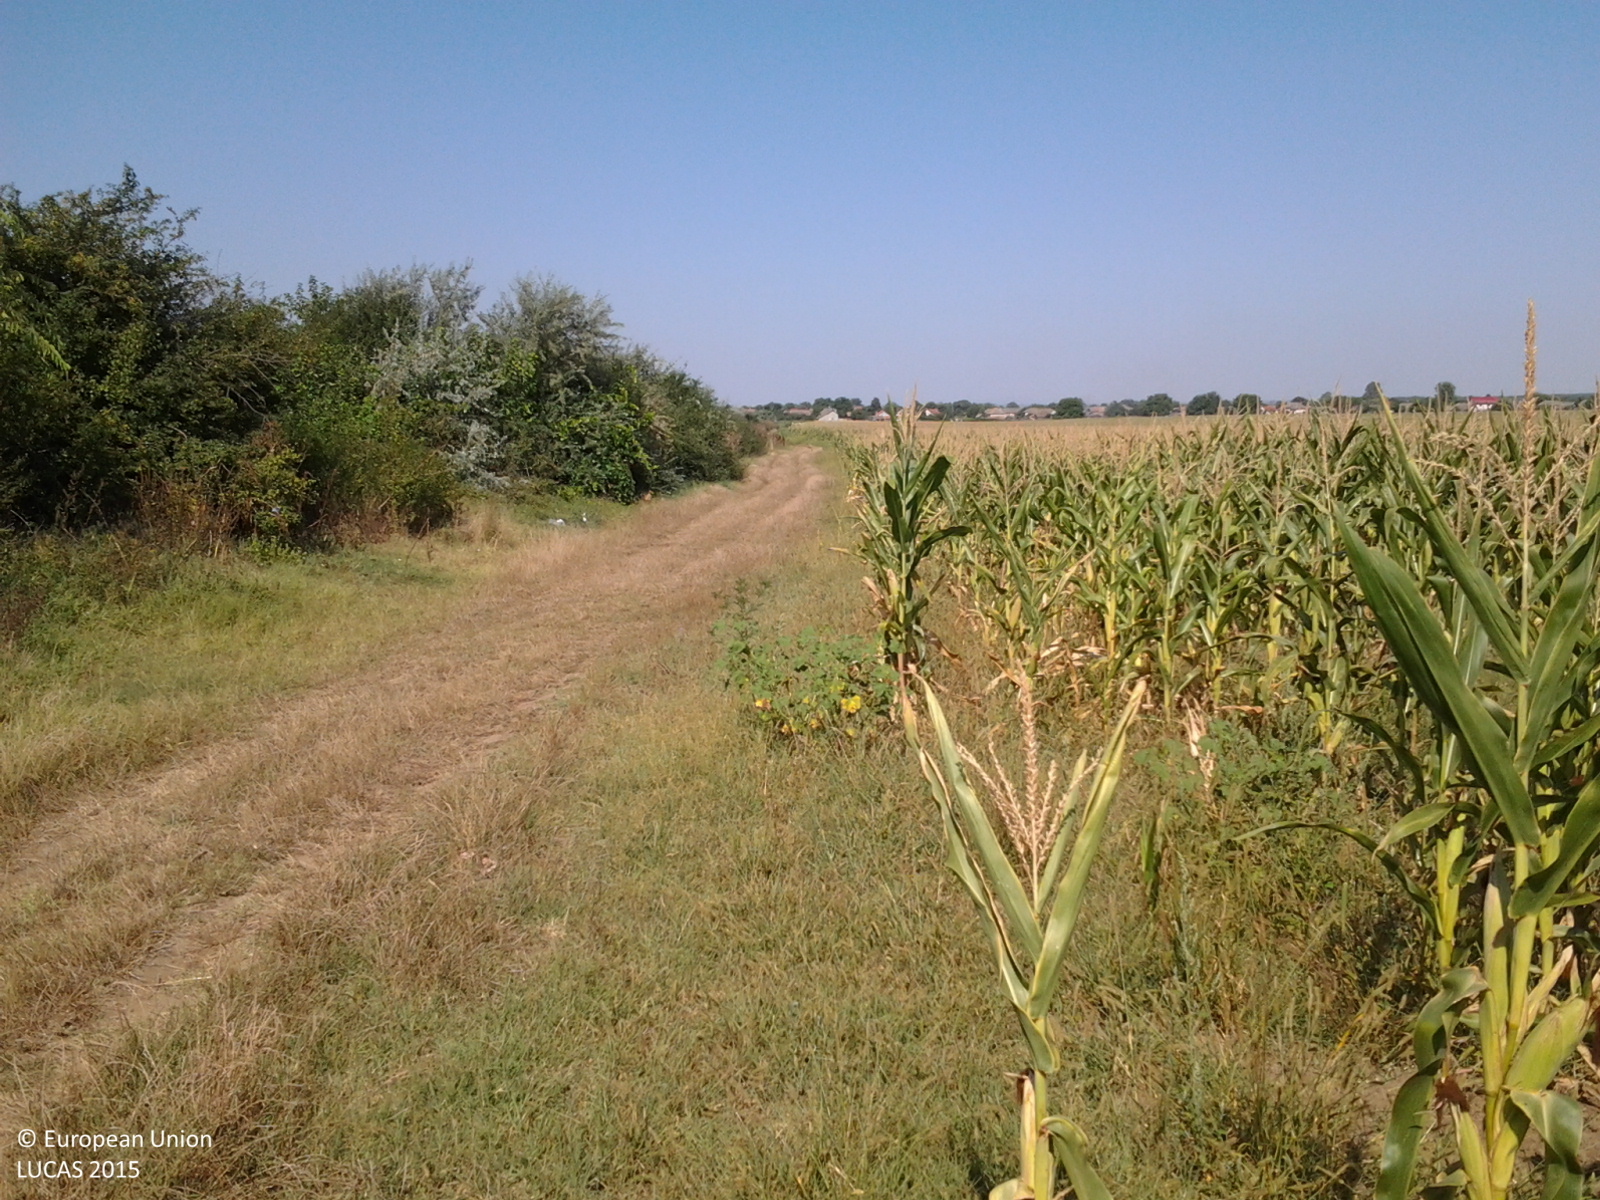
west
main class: Cropland
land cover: Maize
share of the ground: > 75 %
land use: Agriculture (excluding fallow land and kitchen gardens)
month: August
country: RO
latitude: 43.9418
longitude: 22.9095
